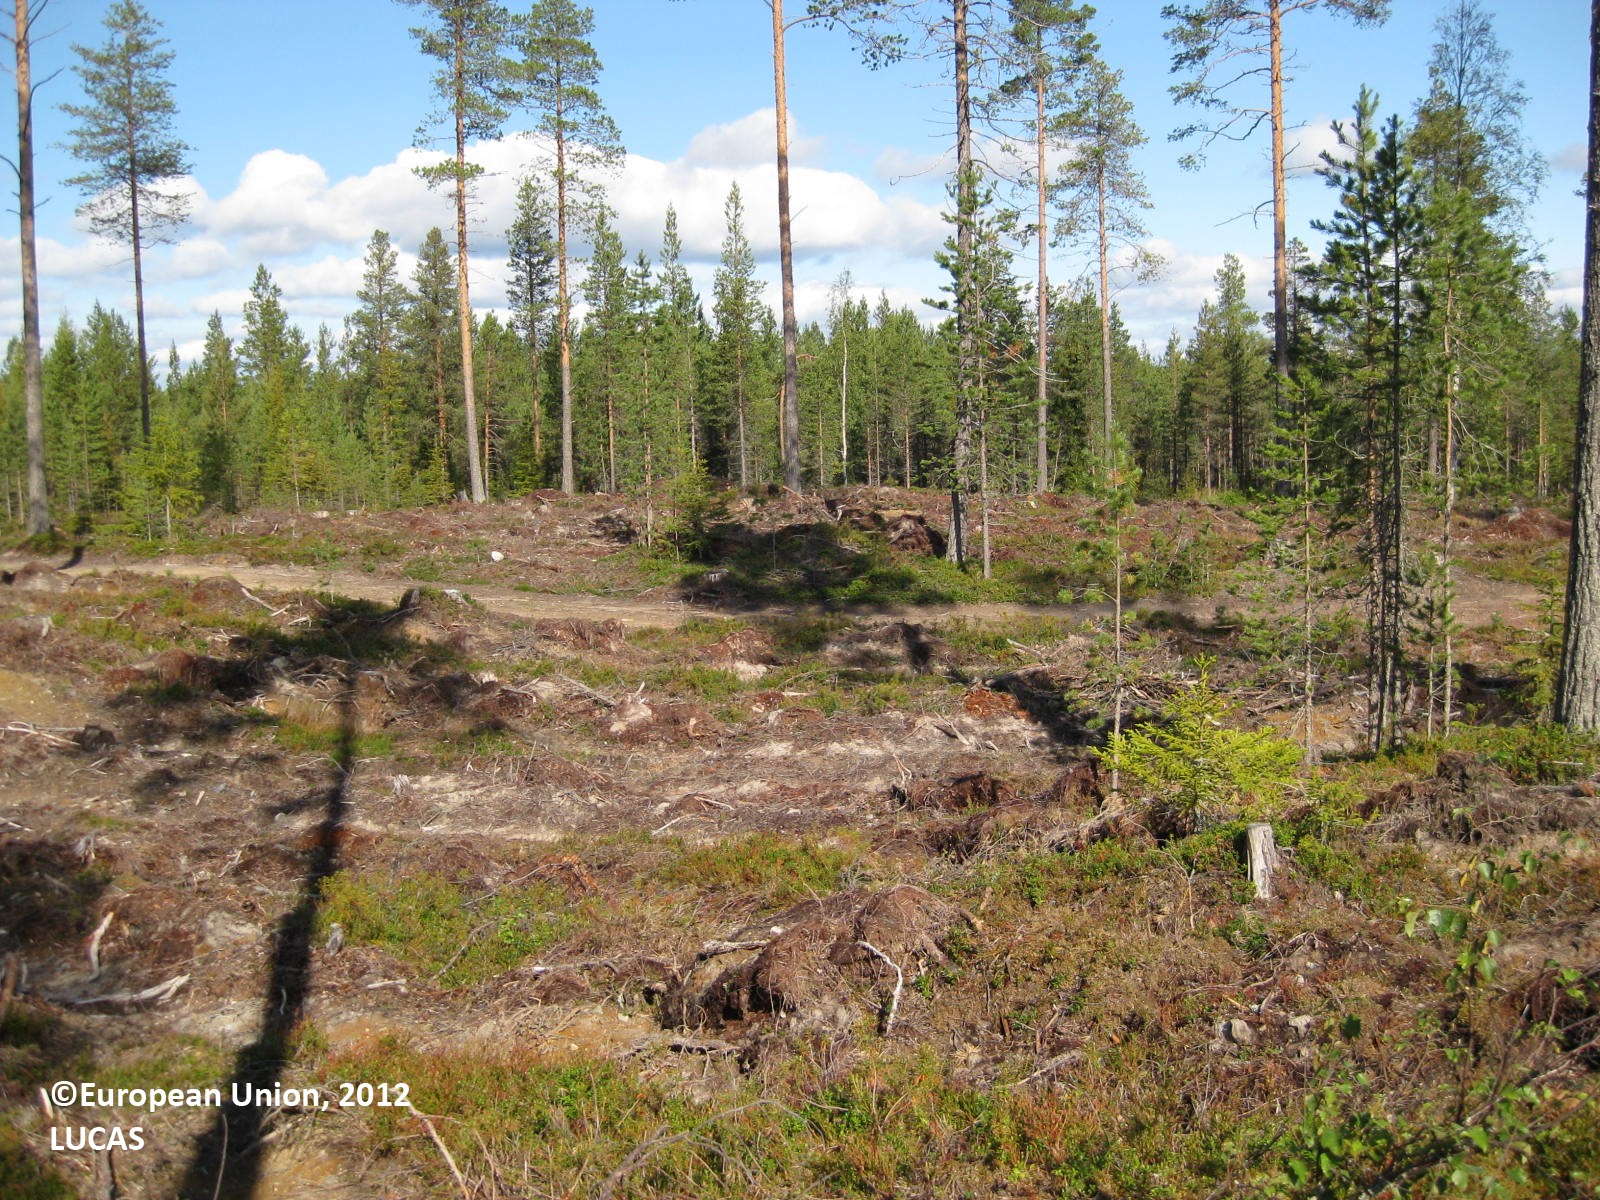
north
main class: Woodland
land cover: Pine dominated coniferous woodland
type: boreal forest
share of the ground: 10 - 25 %
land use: Forestry
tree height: > 5 m
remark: Clear cut
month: August
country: FI
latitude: 66.1532
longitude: 28.8498
